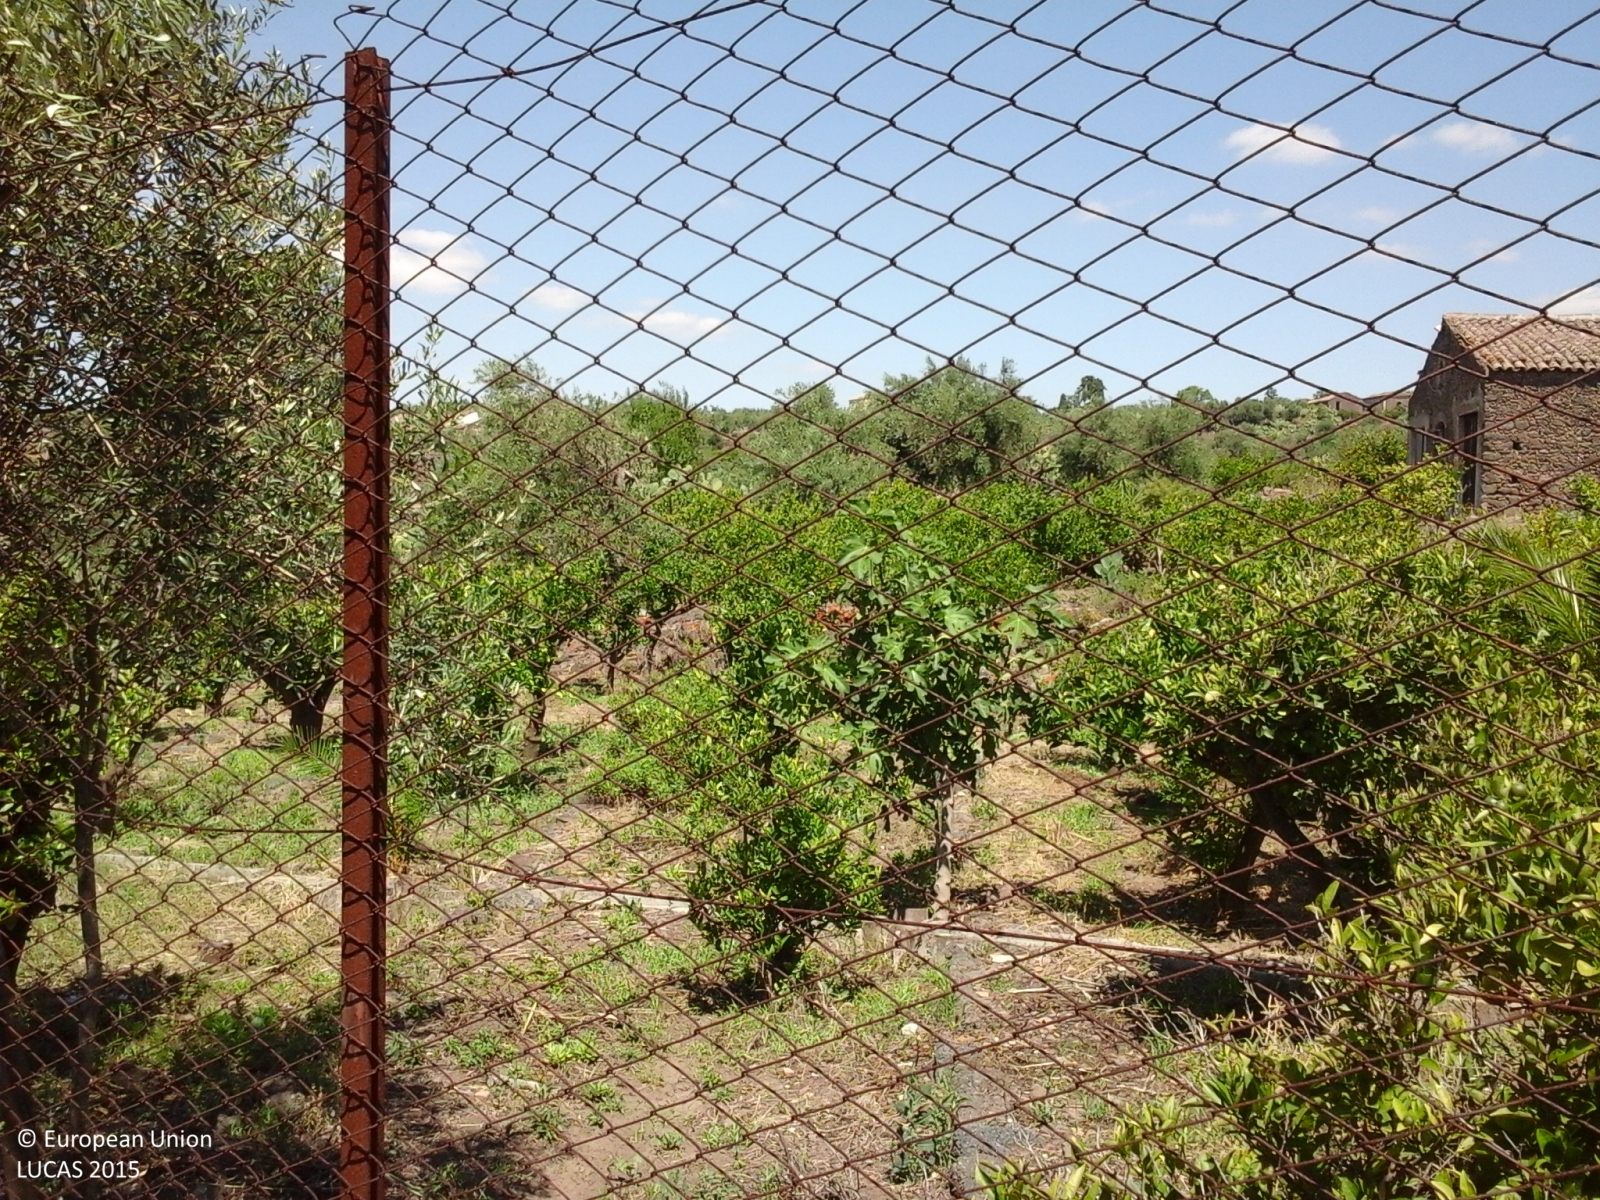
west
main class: Cropland
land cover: Other fruit trees and berries
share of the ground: 25 - 50 %
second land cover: Olive groves
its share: > 75 %
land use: Agriculture (excluding fallow land and kitchen gardens)
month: June
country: IT
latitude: 37.6046
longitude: 14.8700
